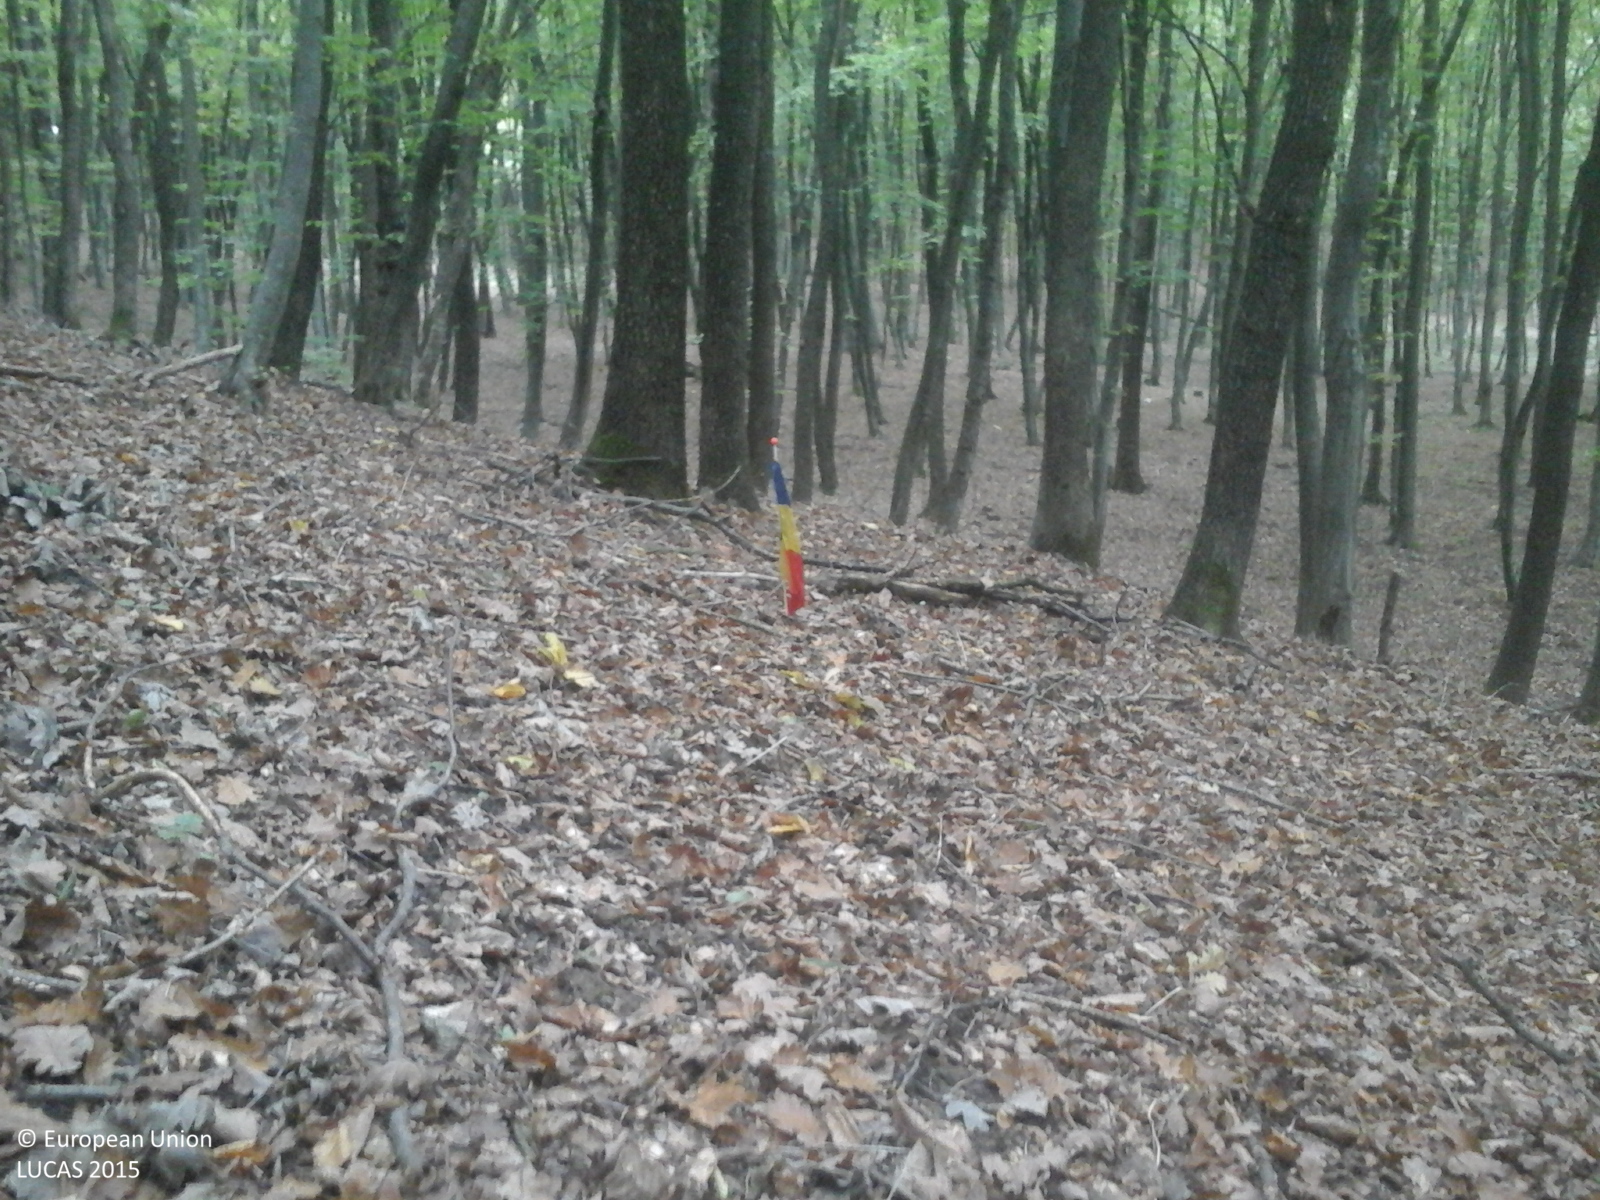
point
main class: Woodland
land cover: Broadleaved woodland
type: acidophilous oak and oak-birch forest
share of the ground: > 75 %
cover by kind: broadleaved forest trees 100 %
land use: Forestry
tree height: > 5 m
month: October
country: RO
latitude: 46.1333
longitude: 24.8338
